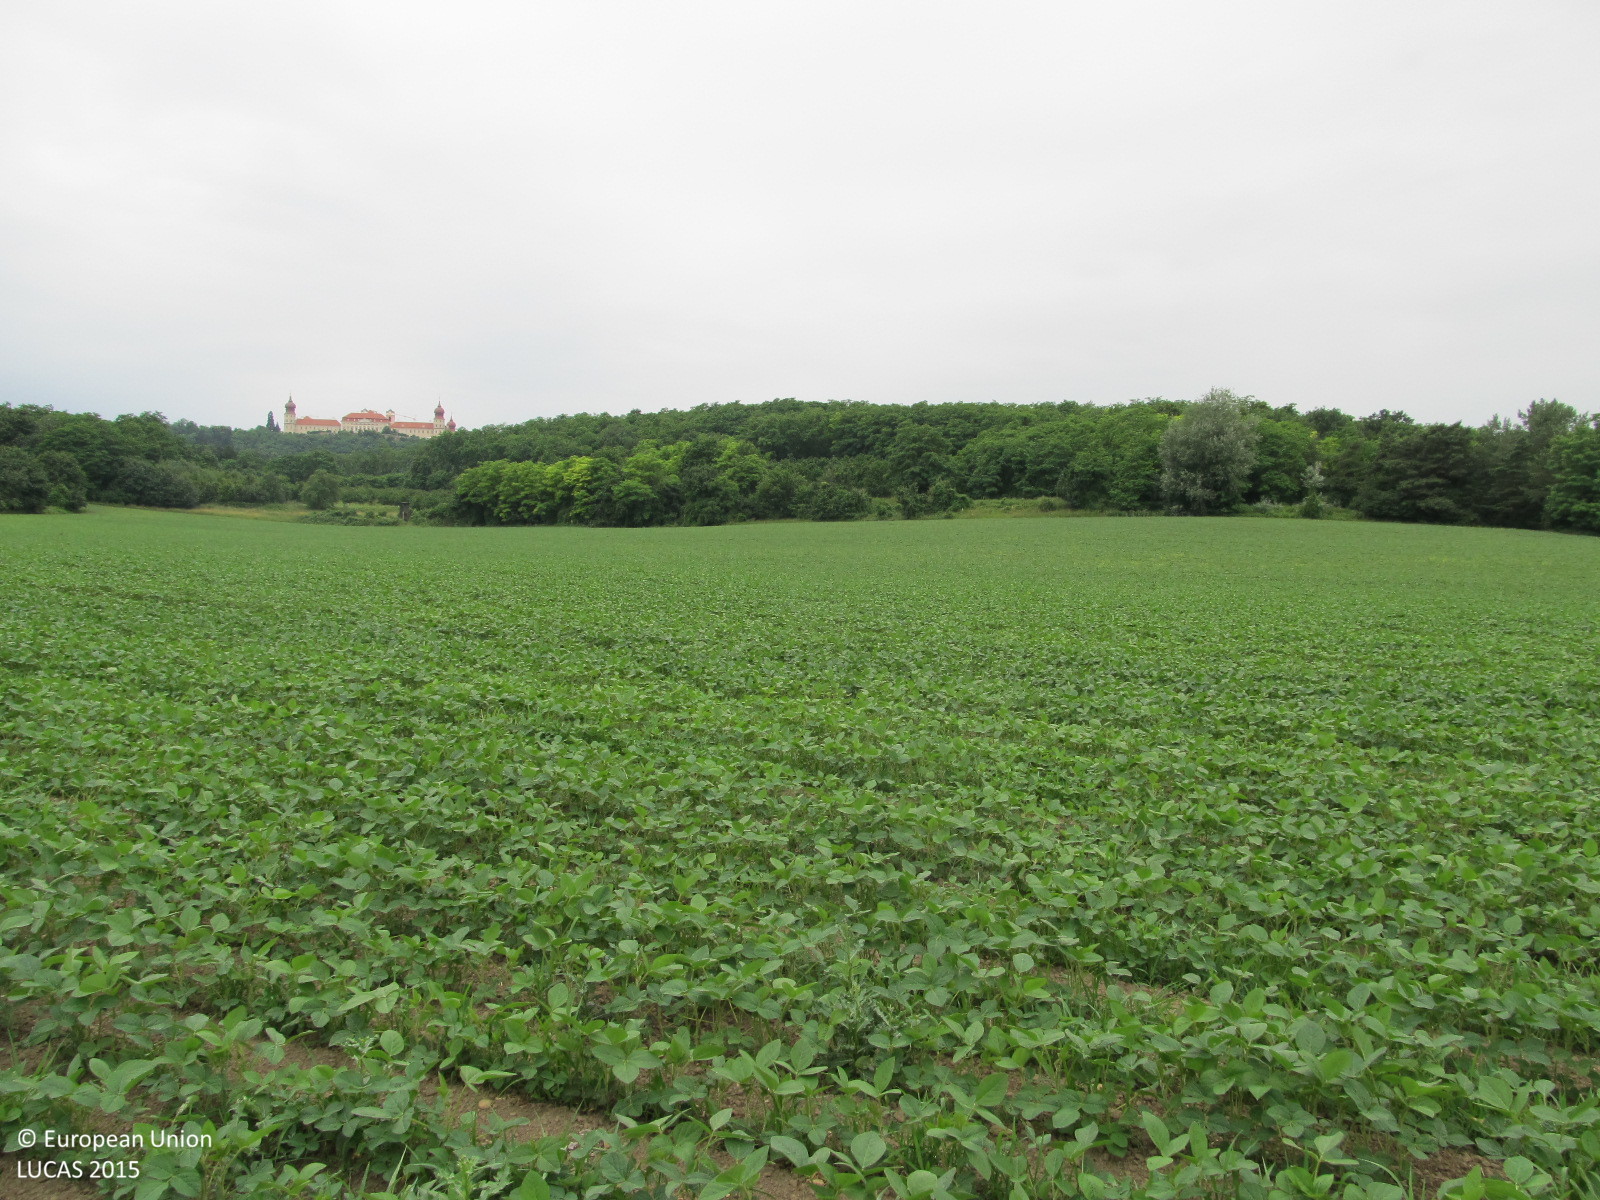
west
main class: Cropland
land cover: Soya
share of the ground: 50 - 75 %
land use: Agriculture (excluding fallow land and kitchen gardens)
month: June
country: AT
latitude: 48.3682
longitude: 15.6319
